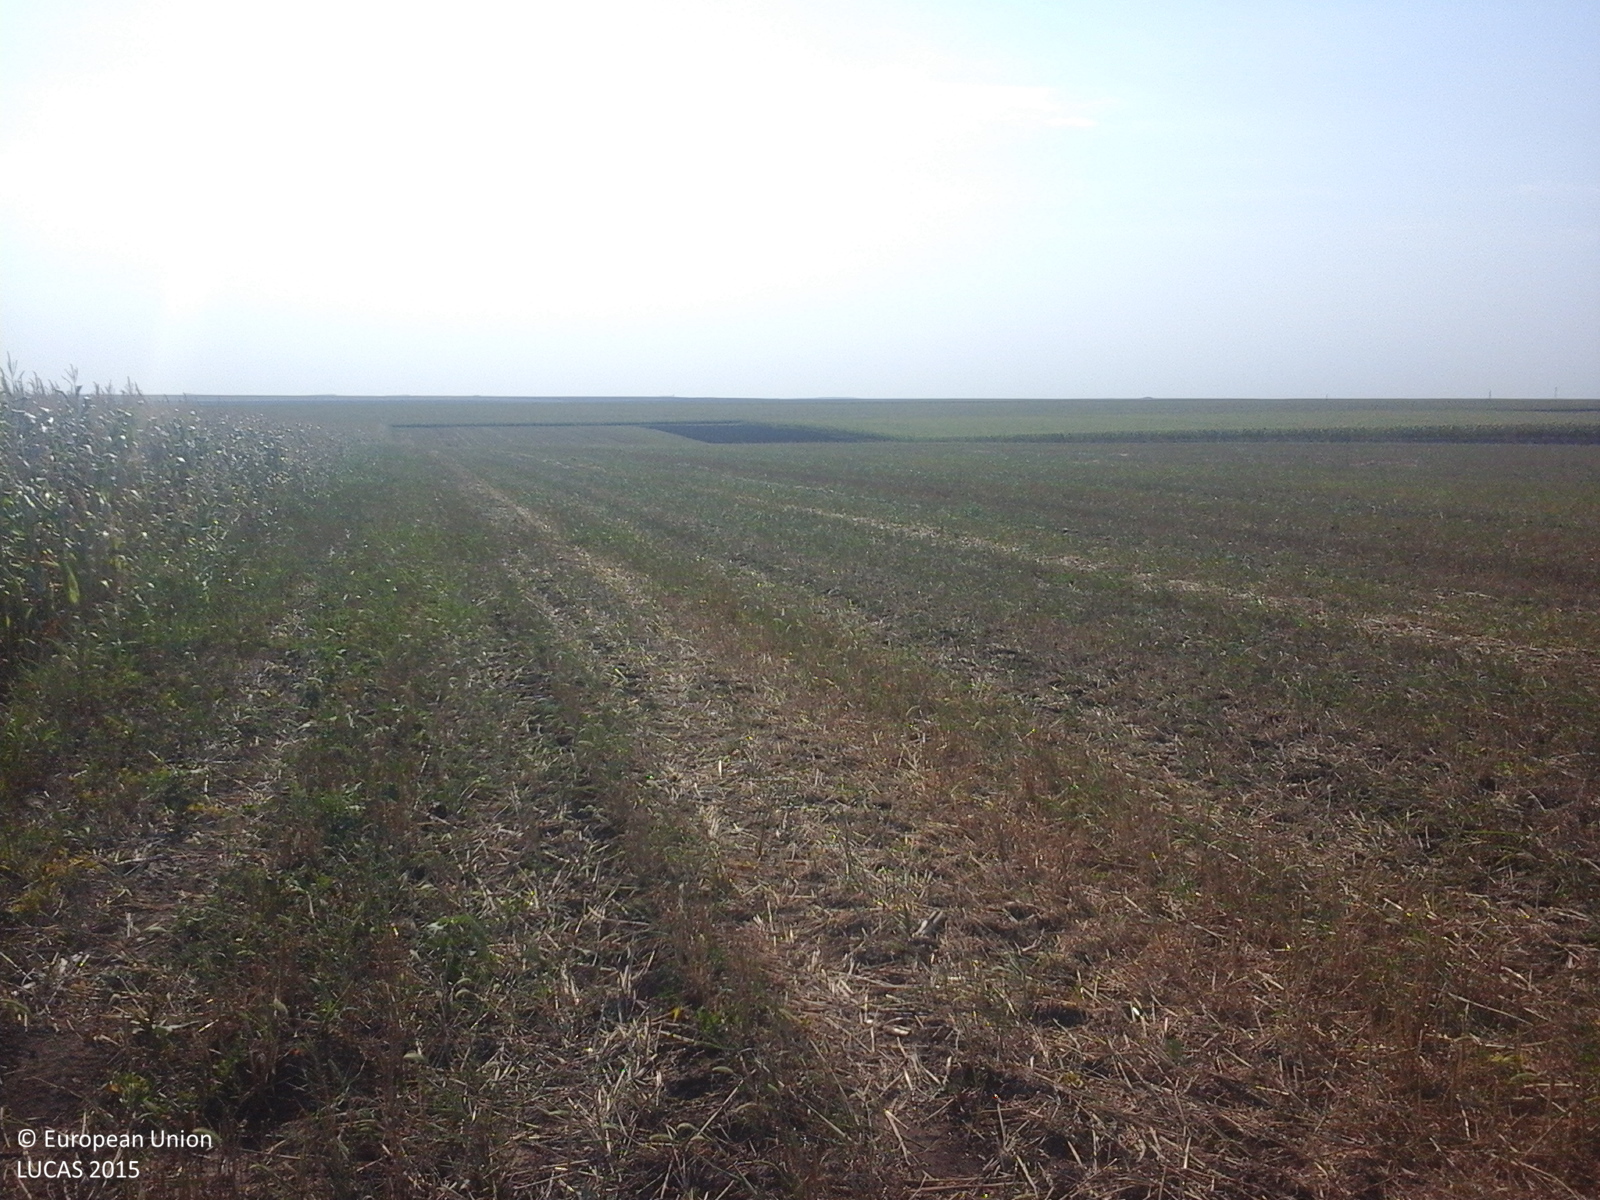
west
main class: Cropland
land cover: Maize
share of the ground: > 75 %
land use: Agriculture (excluding fallow land and kitchen gardens)
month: August
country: RO
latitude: 43.9187
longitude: 28.1257
